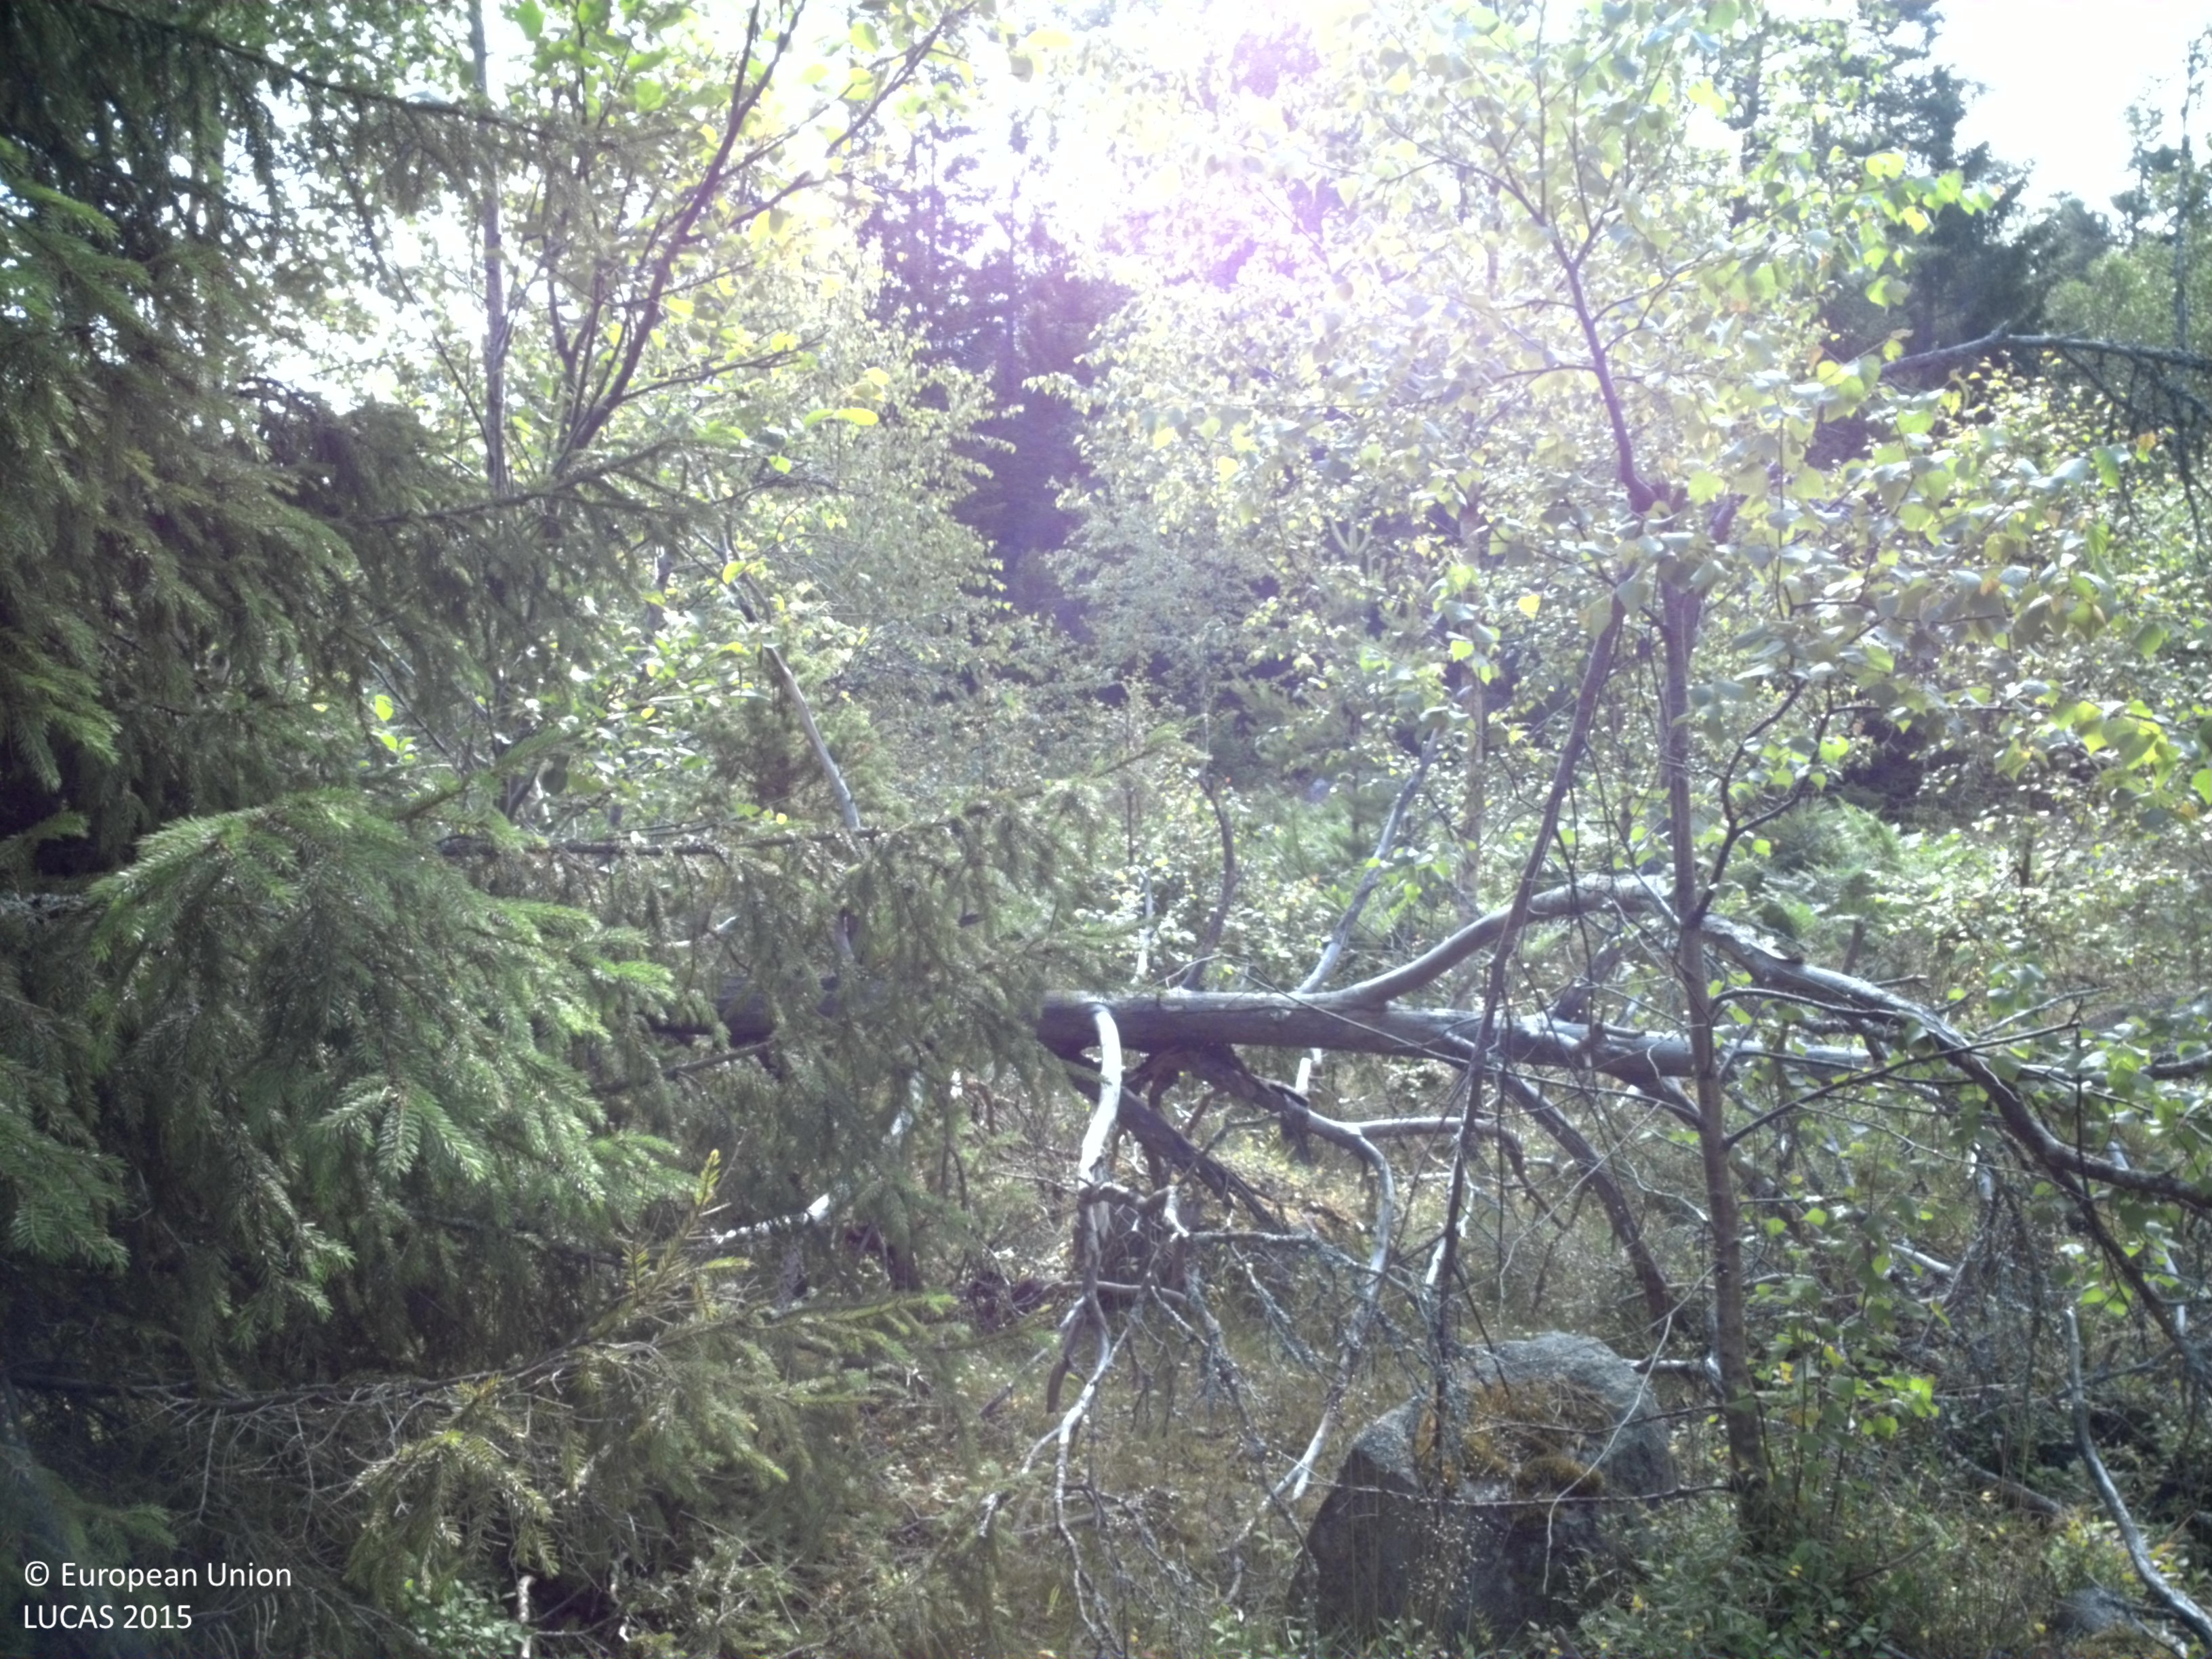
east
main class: Woodland
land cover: Spruce dominated mixed woodland
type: boreal forest
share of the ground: 50 - 75 %
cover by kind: coniferous forest trees 45 %, lichens and mosses 30 %, broadleaved forest trees 15 %, shrubs 10 %
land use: Forestry
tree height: > 5 m
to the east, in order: Spruce dominated mixed woodland; Other coniferous woodland; Spruce dominated coniferous woodland
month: July
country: SE
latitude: 60.0003
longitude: 18.7310
